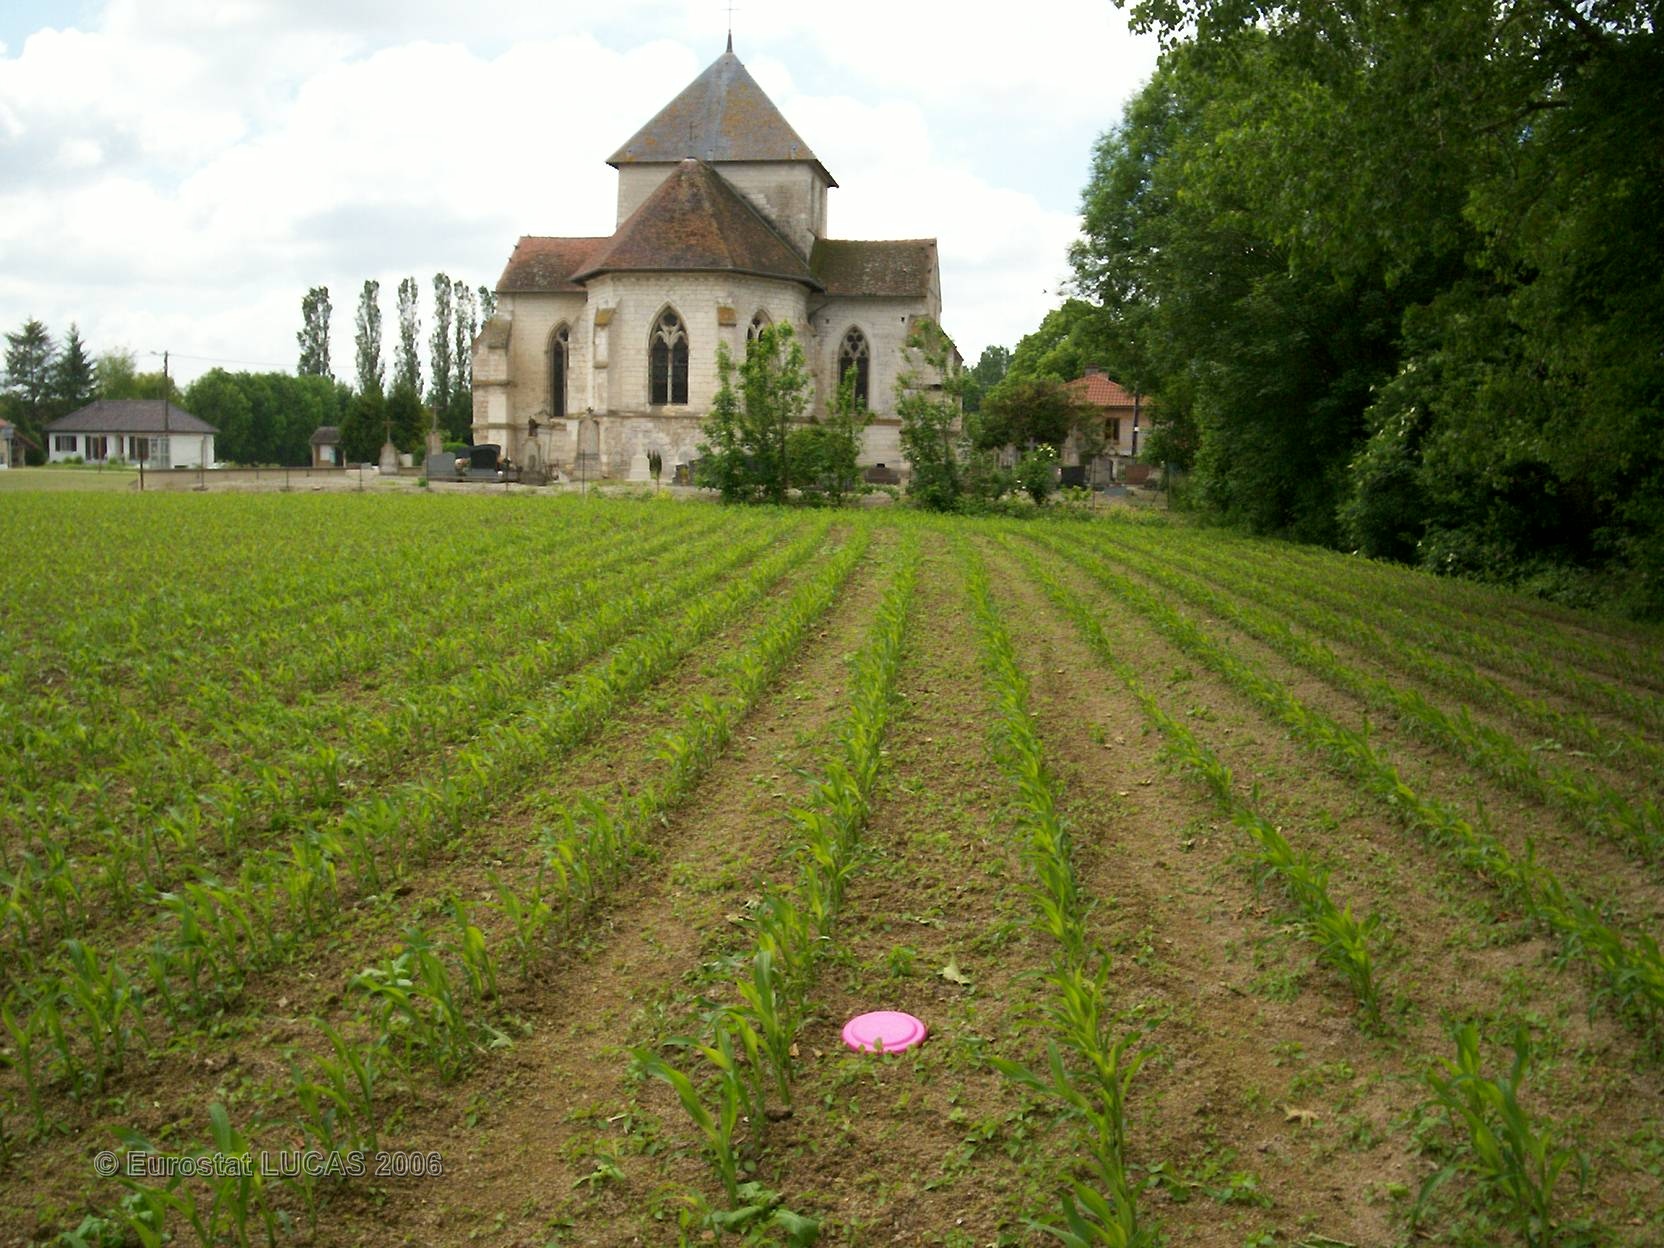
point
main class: Cropland
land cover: Maize
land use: Agriculture (excluding fallow land and kitchen gardens)
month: June
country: FR
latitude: 48.6592
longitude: 4.4169
